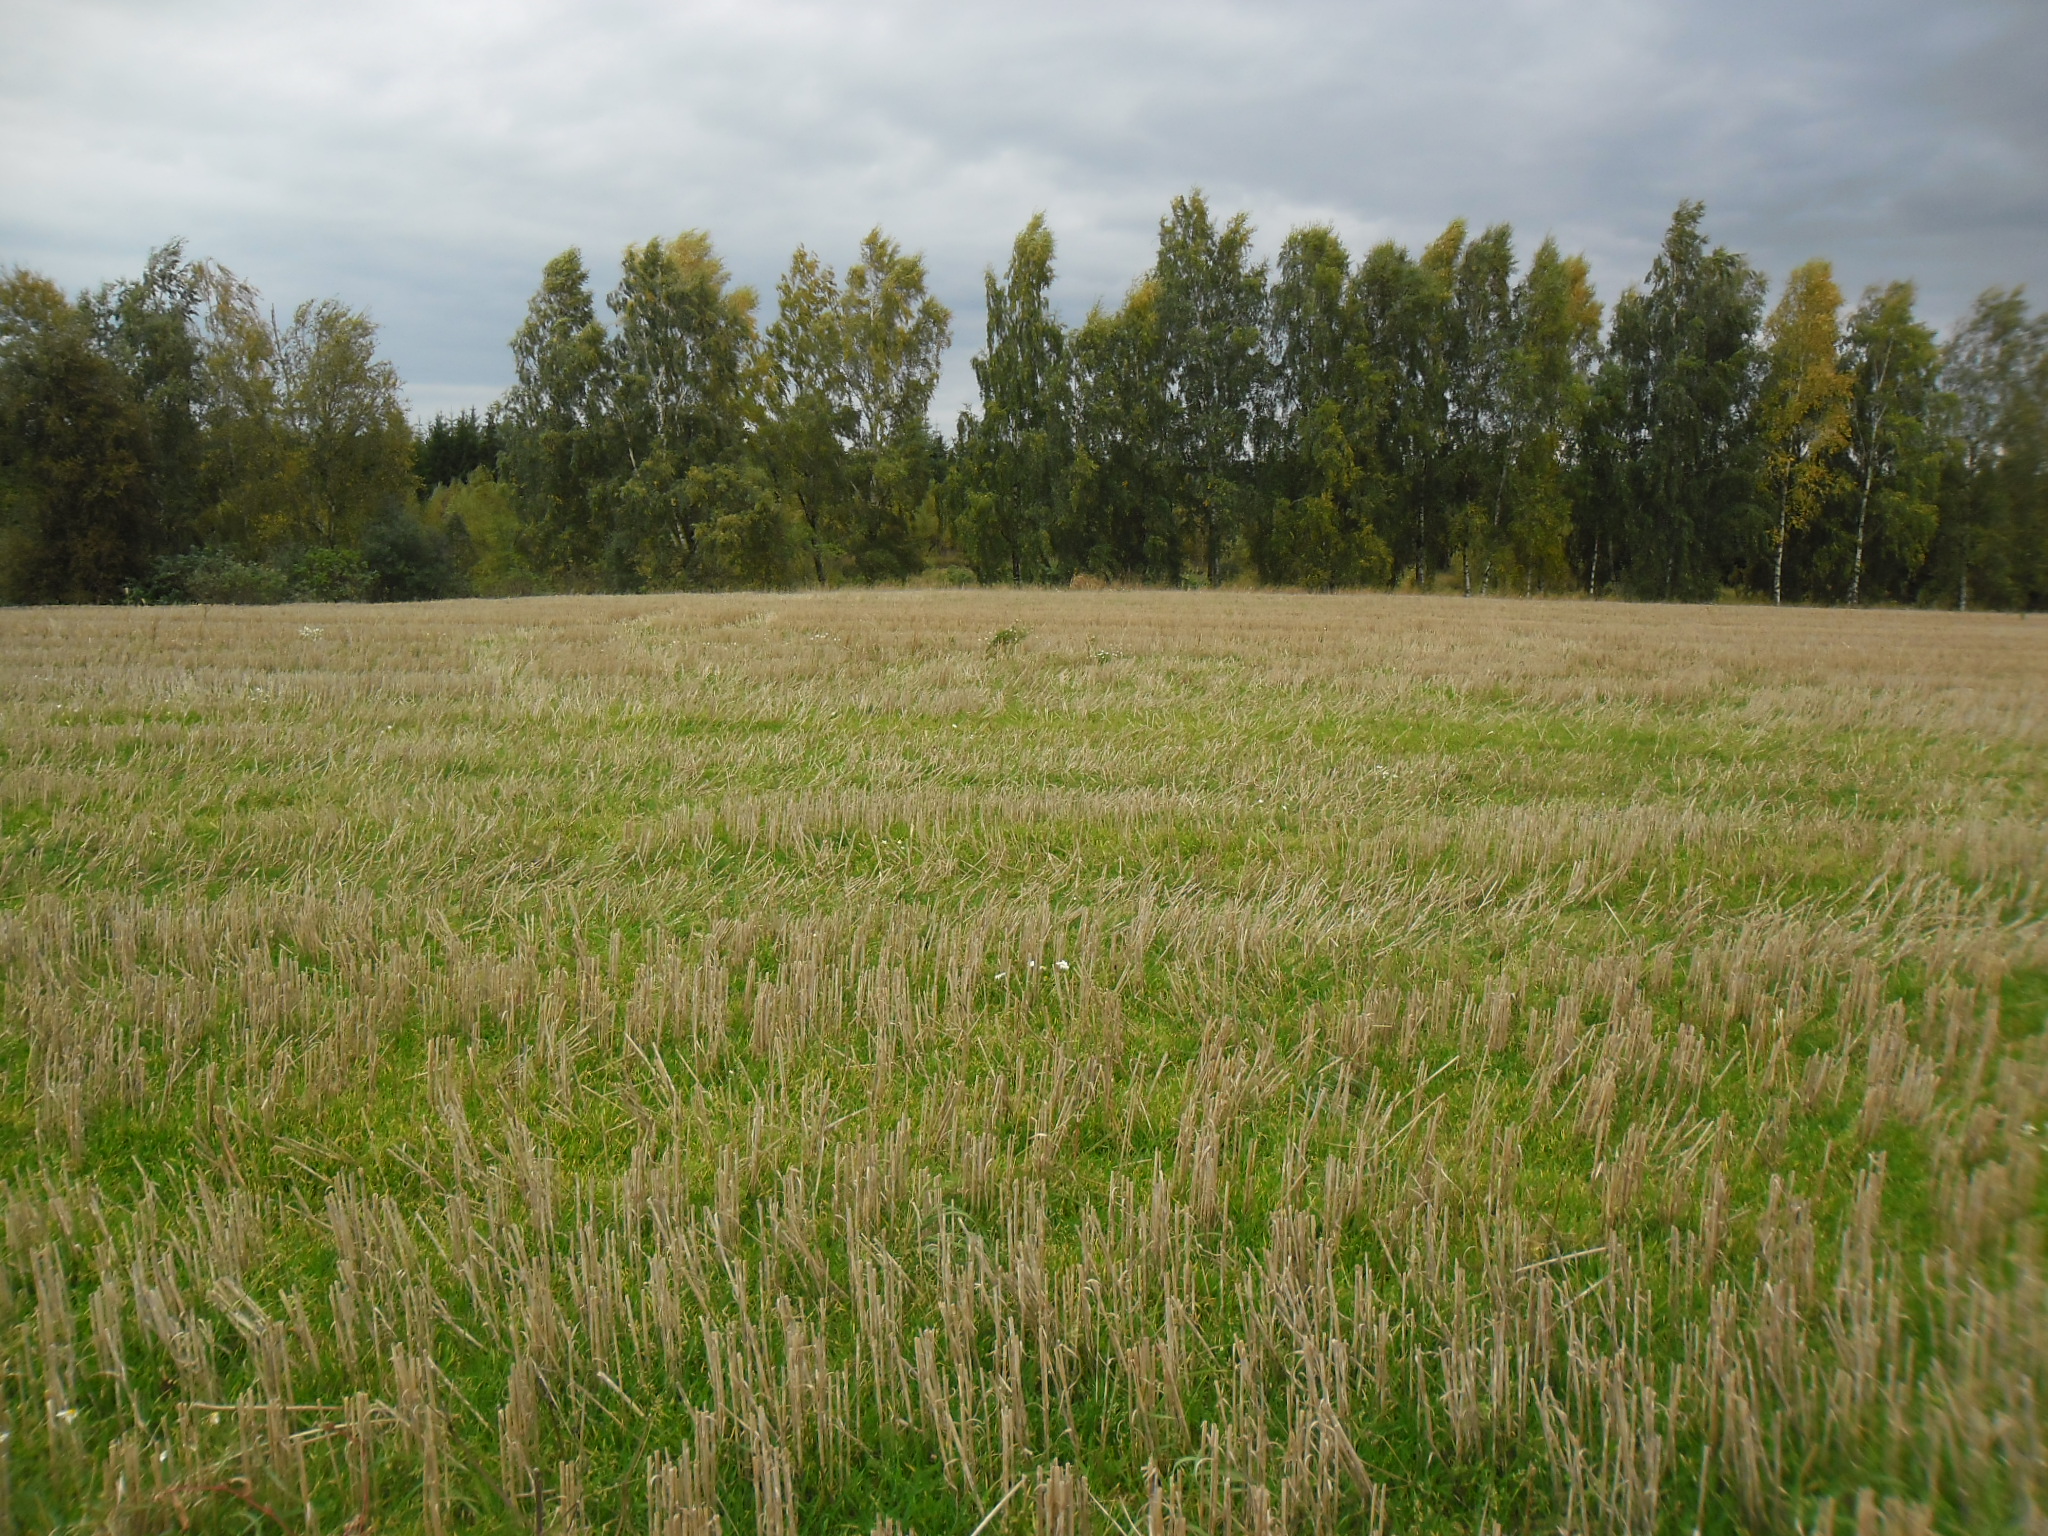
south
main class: Cropland
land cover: Barley
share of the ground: 10 - 25 %
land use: Agriculture (excluding fallow land and kitchen gardens)
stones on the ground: < 10 %
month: October
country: SE
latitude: 56.5281
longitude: 13.1021
